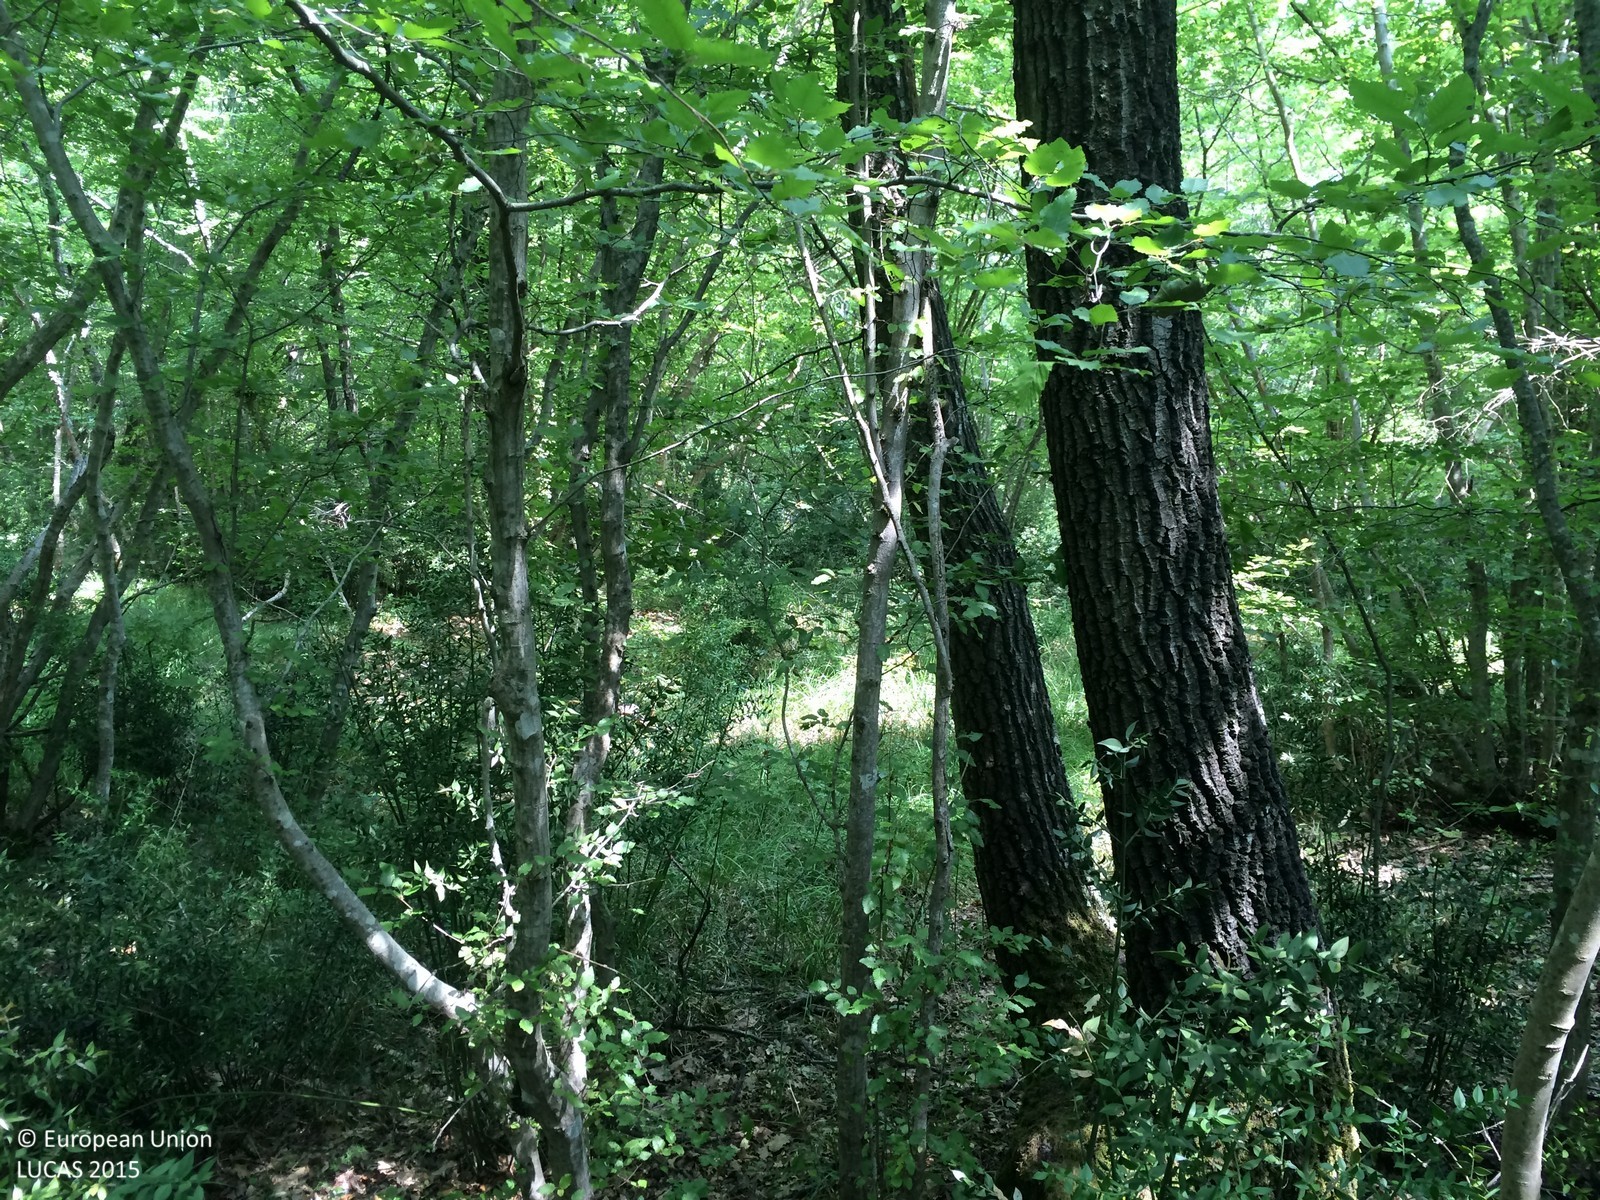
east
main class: Woodland
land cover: Broadleaved woodland
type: beech forest
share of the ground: > 75 %
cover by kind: broadleaved forest trees 90 %, shrubs 10 %
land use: Semi-natural and natural areas not in use
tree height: > 5 m
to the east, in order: Broadleaved woodland; Dry stone walls; Broadleaved woodland; Dry stone walls; Broadleaved woodland
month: June
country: HR
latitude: 45.1114
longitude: 13.7950
